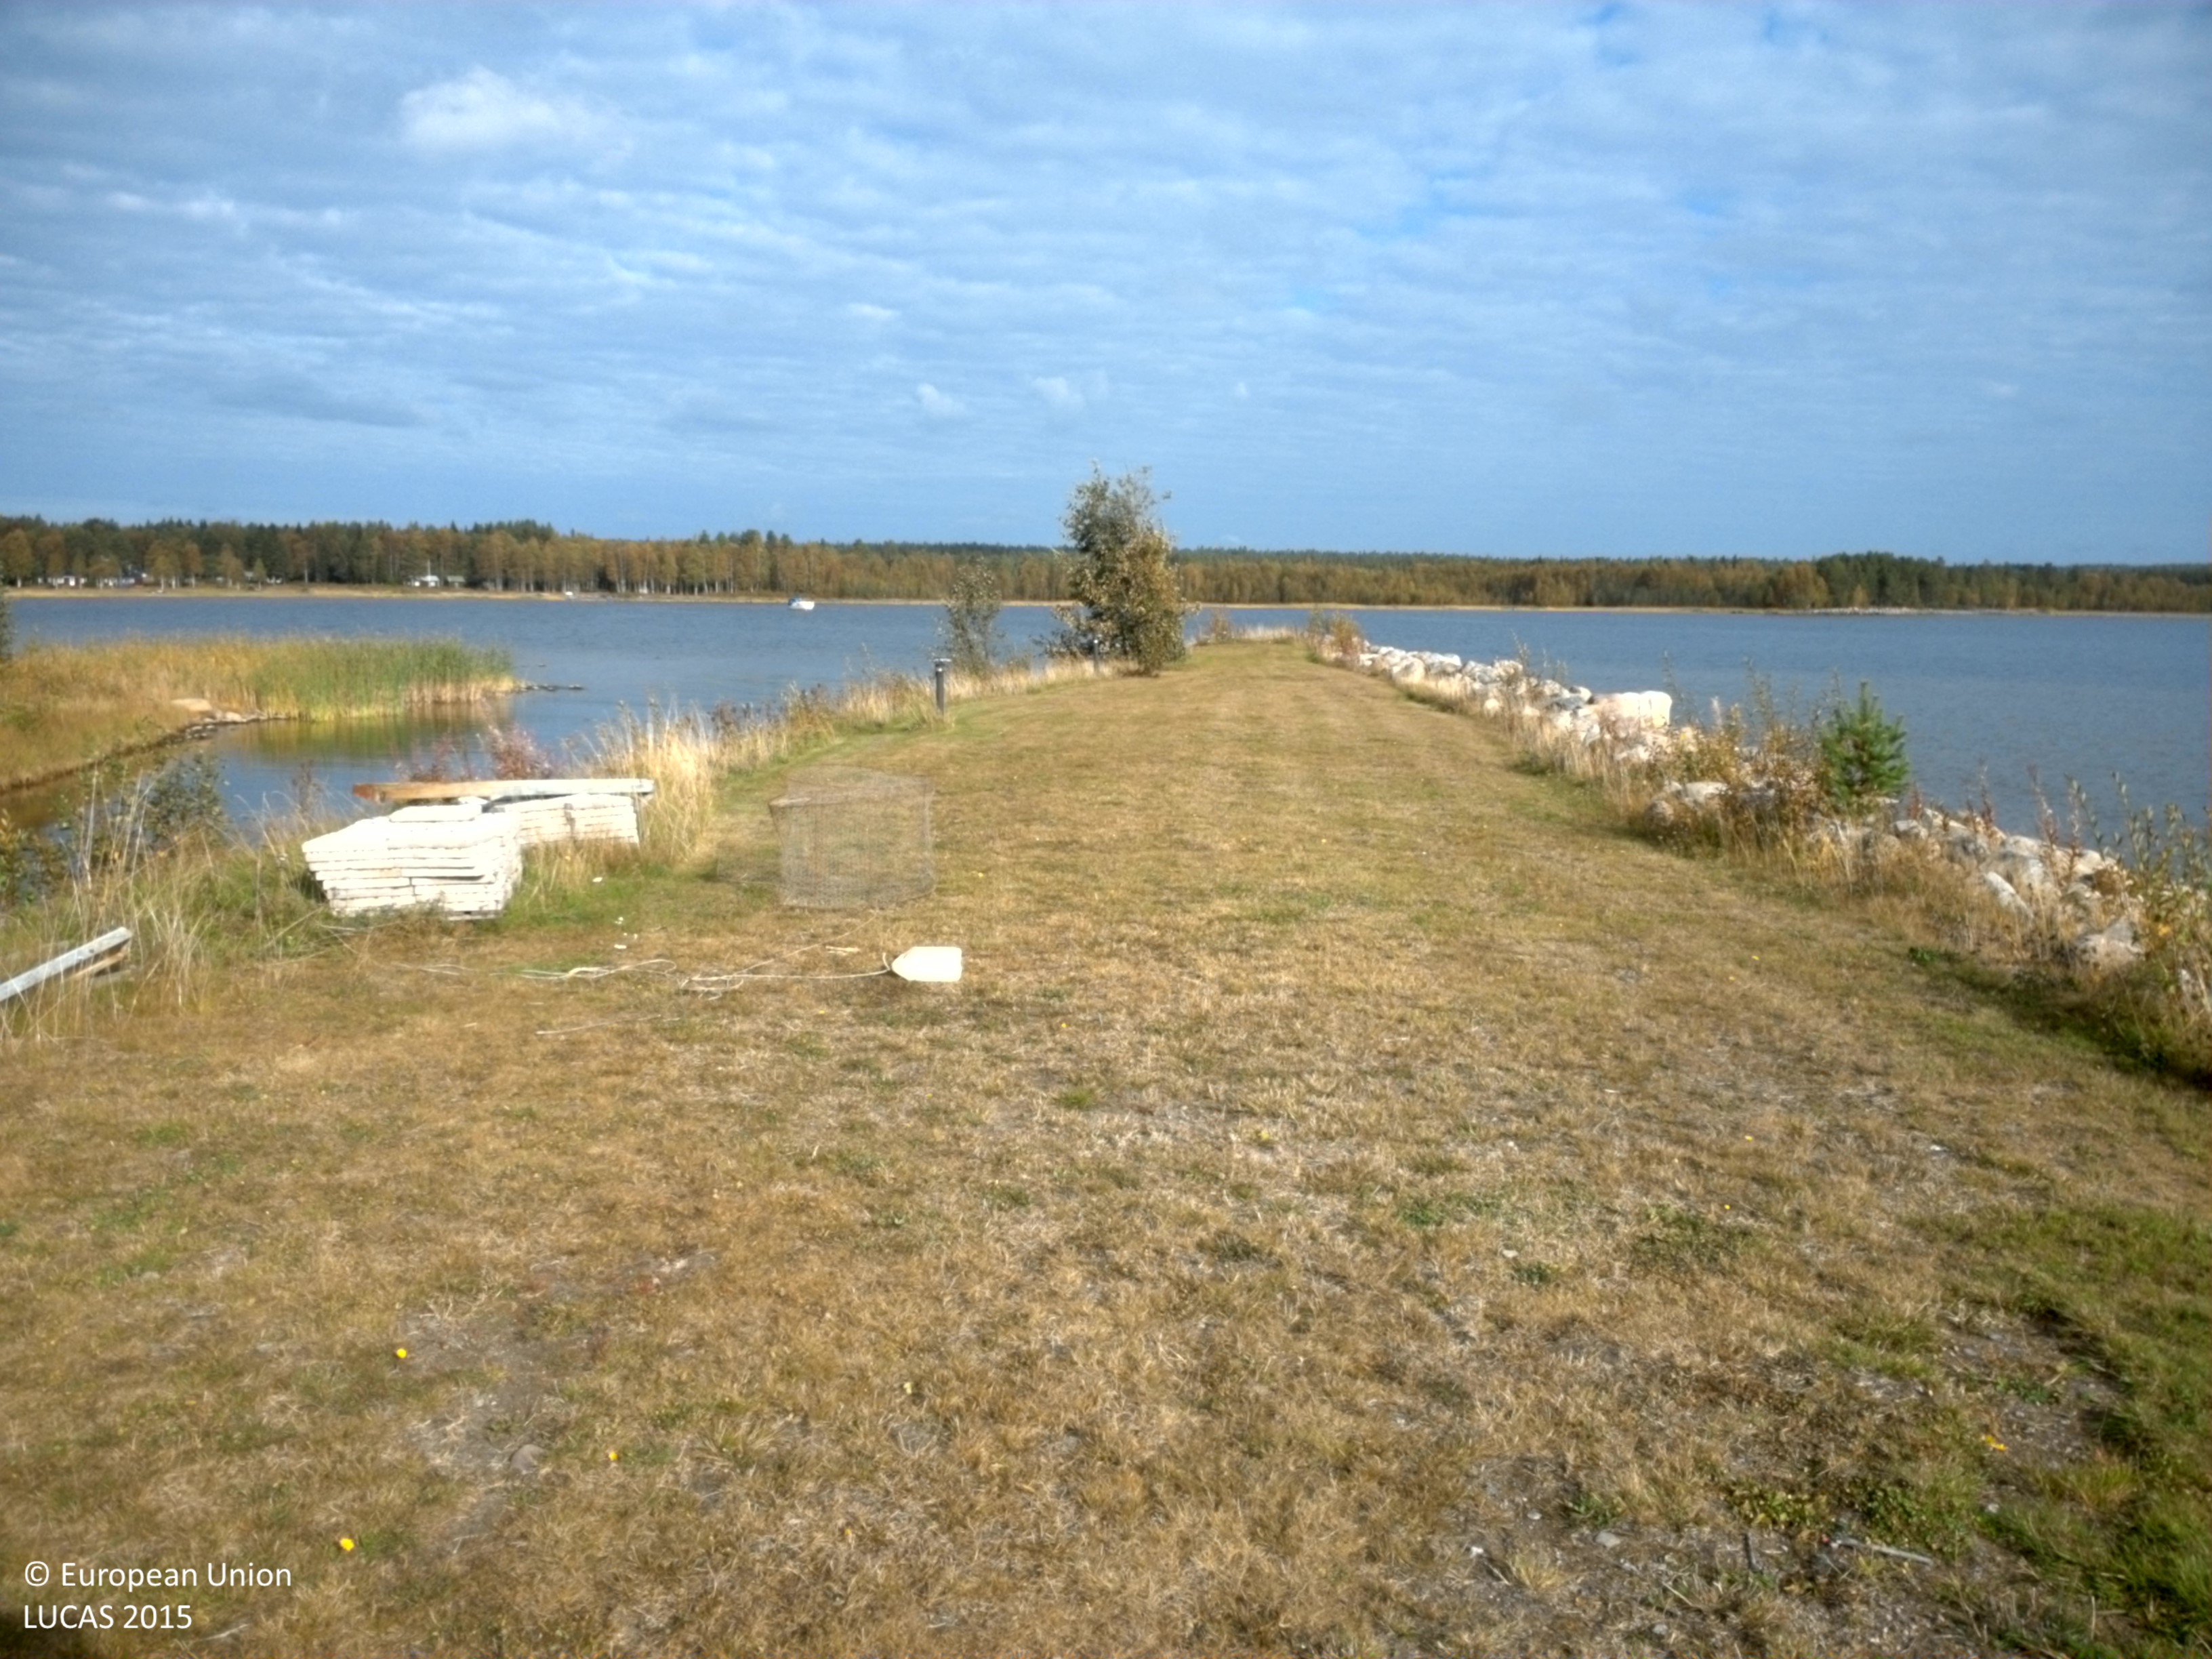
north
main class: Grassland
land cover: Grassland without tree/shrub cover
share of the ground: > 75 %
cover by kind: herbaceous plants 100 %
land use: Residential
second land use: Amenities, museums, leisure
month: September
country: SE
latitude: 65.4325
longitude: 21.8991
